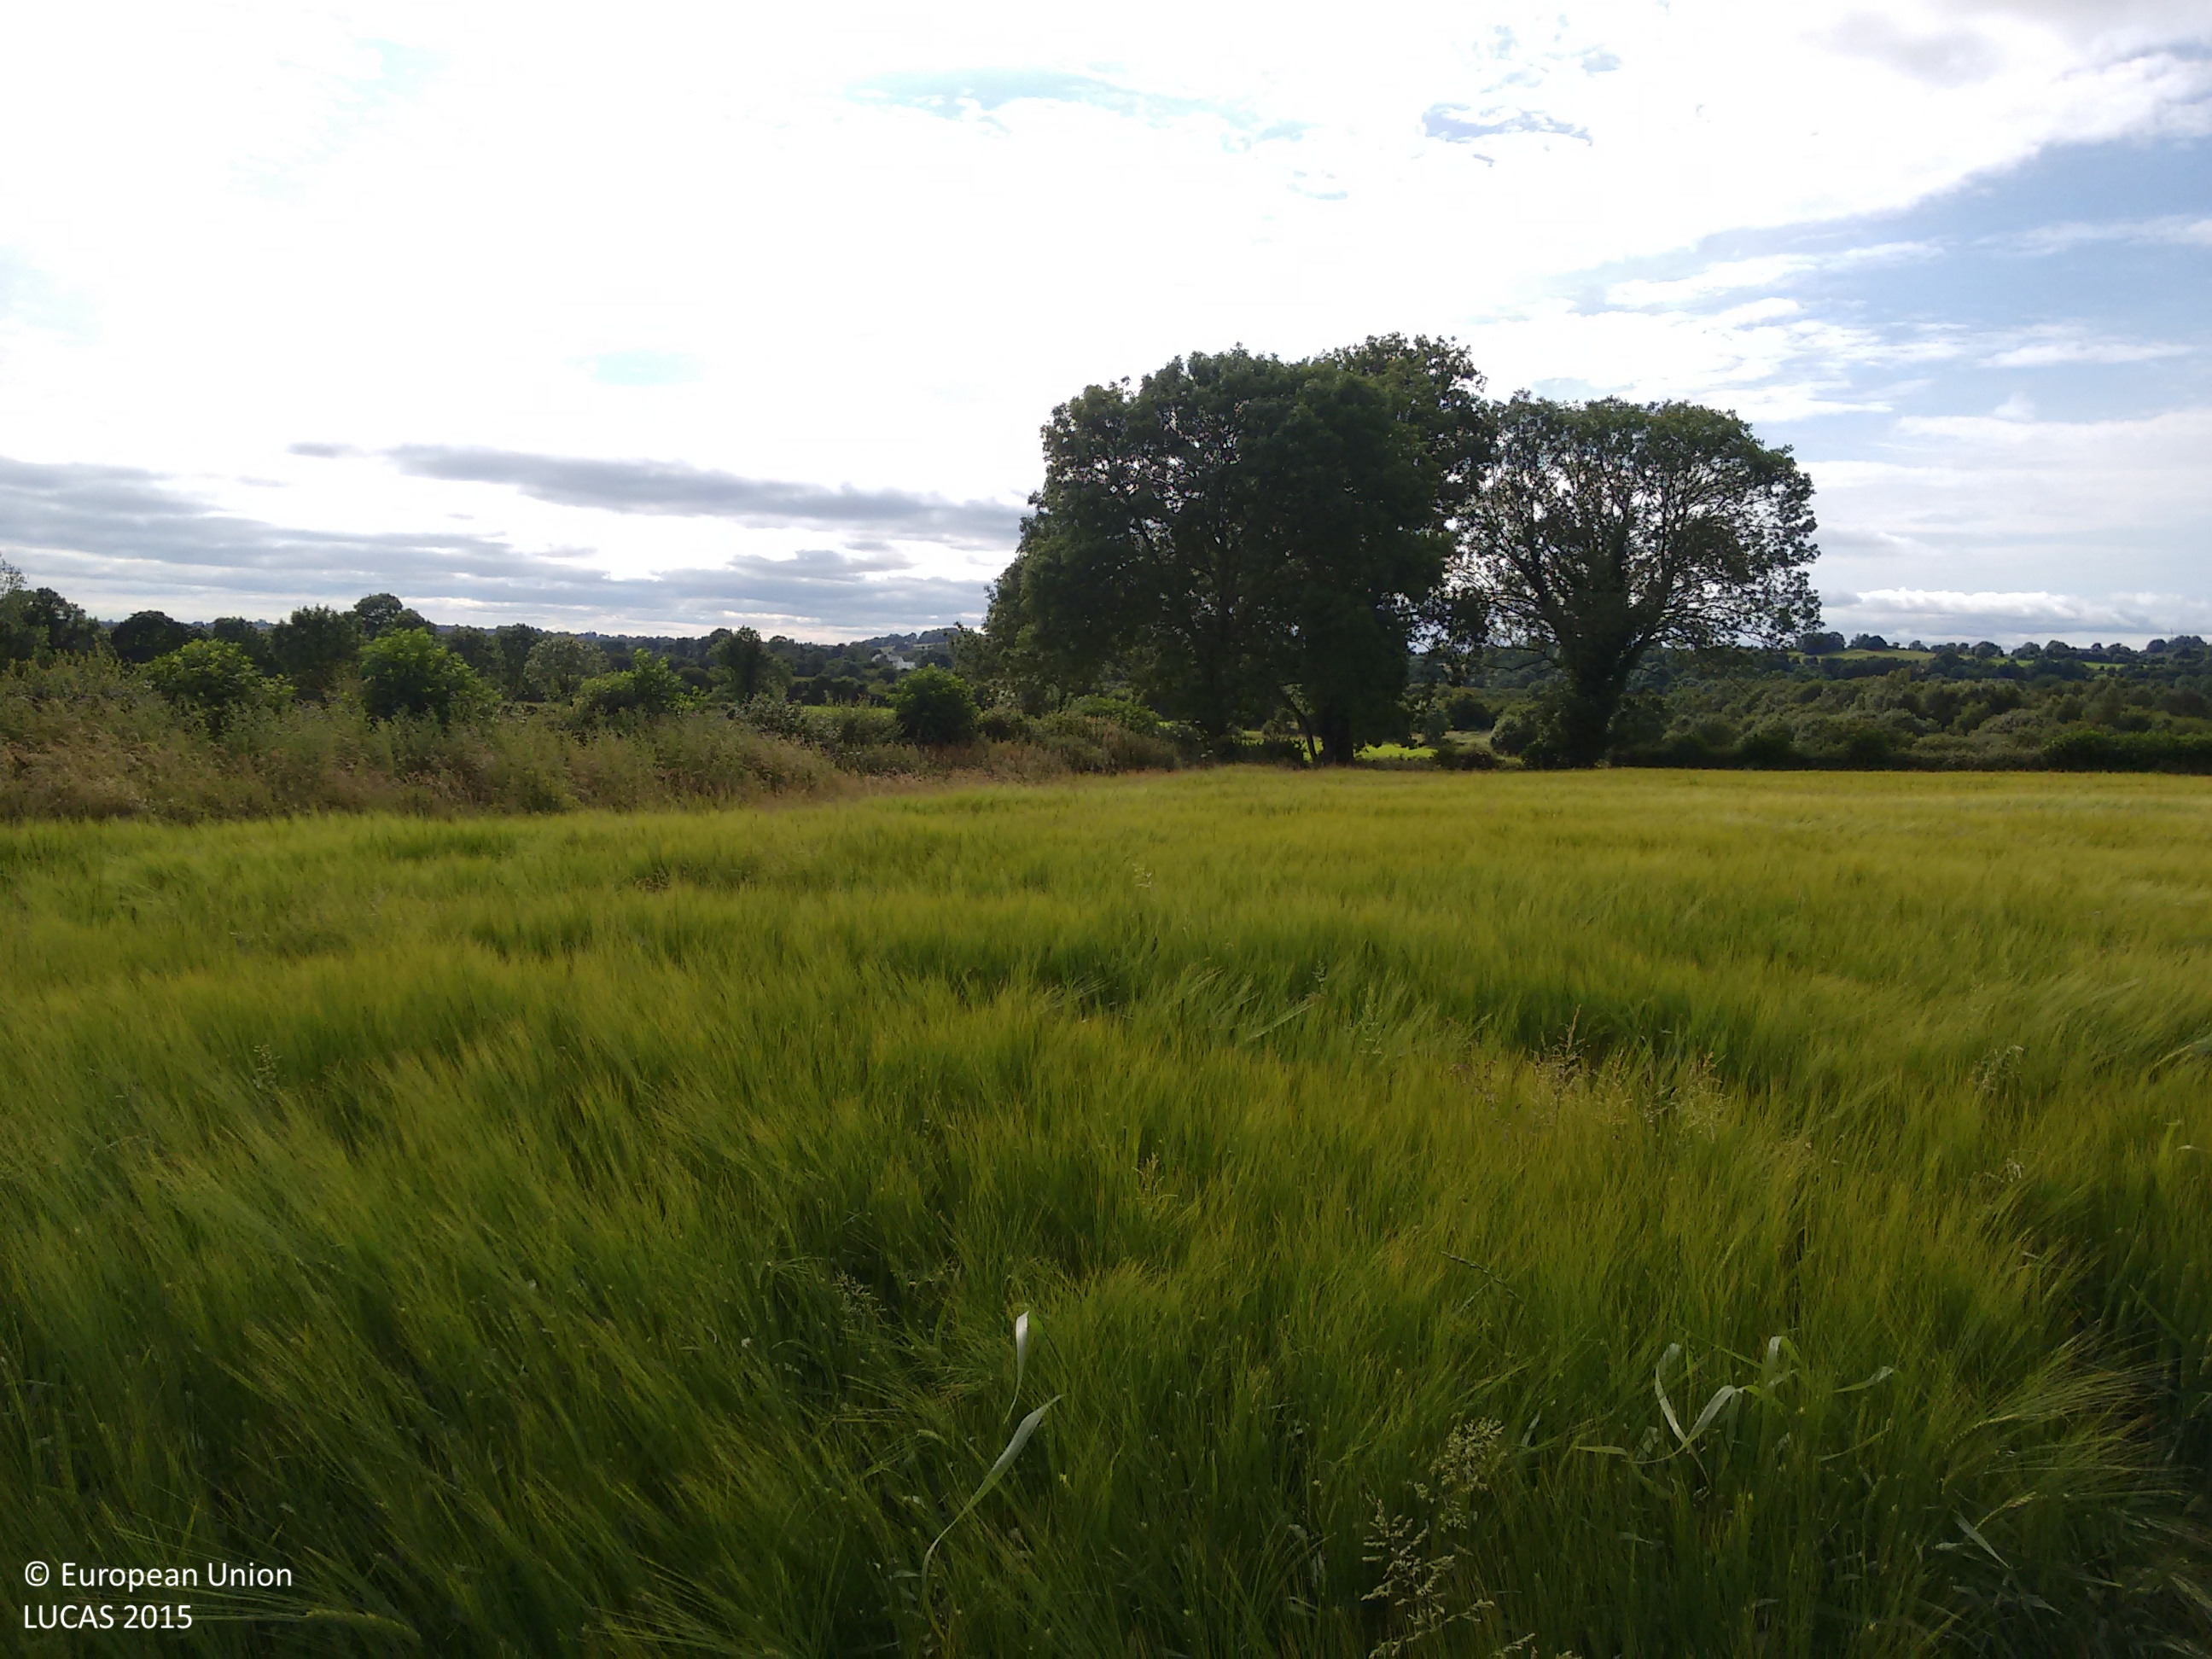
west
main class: Cropland
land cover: Barley
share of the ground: > 75 %
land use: Agriculture (excluding fallow land and kitchen gardens)
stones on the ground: < 10 %
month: July
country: IE
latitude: 53.4677
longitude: -7.8084
